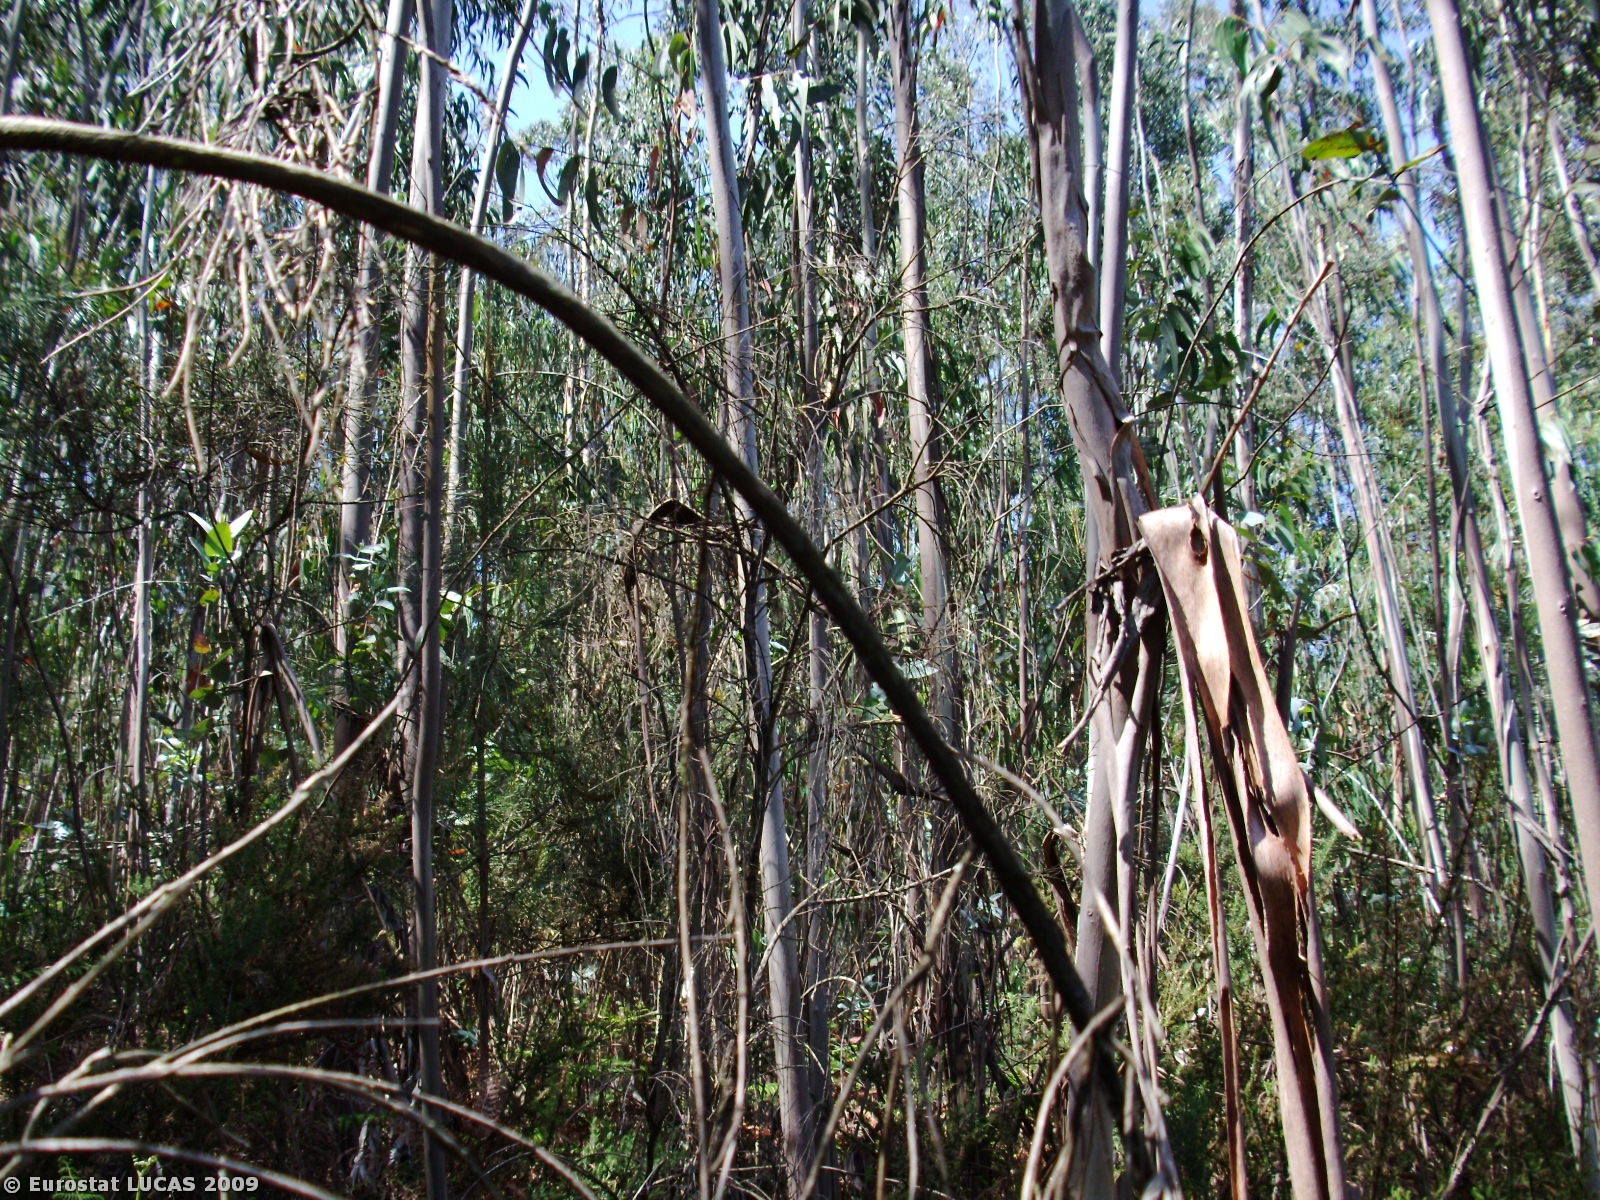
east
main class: Woodland
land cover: Broadleaved woodland
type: plantations and self-sown exotic forest
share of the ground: 50 - 75 %
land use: Forestry
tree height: > 5 m
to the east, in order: Broadleaved woodland; Tracks; Broadleaved woodland; Spontaneously vegetated surfaces; Coniferous woodland; Maize; Vineyards; Electric lines; Paved roads, cycling and walking lanes; Grass margins; Vineyards; Maize; Vineyards; Broadleaved woodland
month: May
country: PT
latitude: 41.6843
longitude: -8.6270
